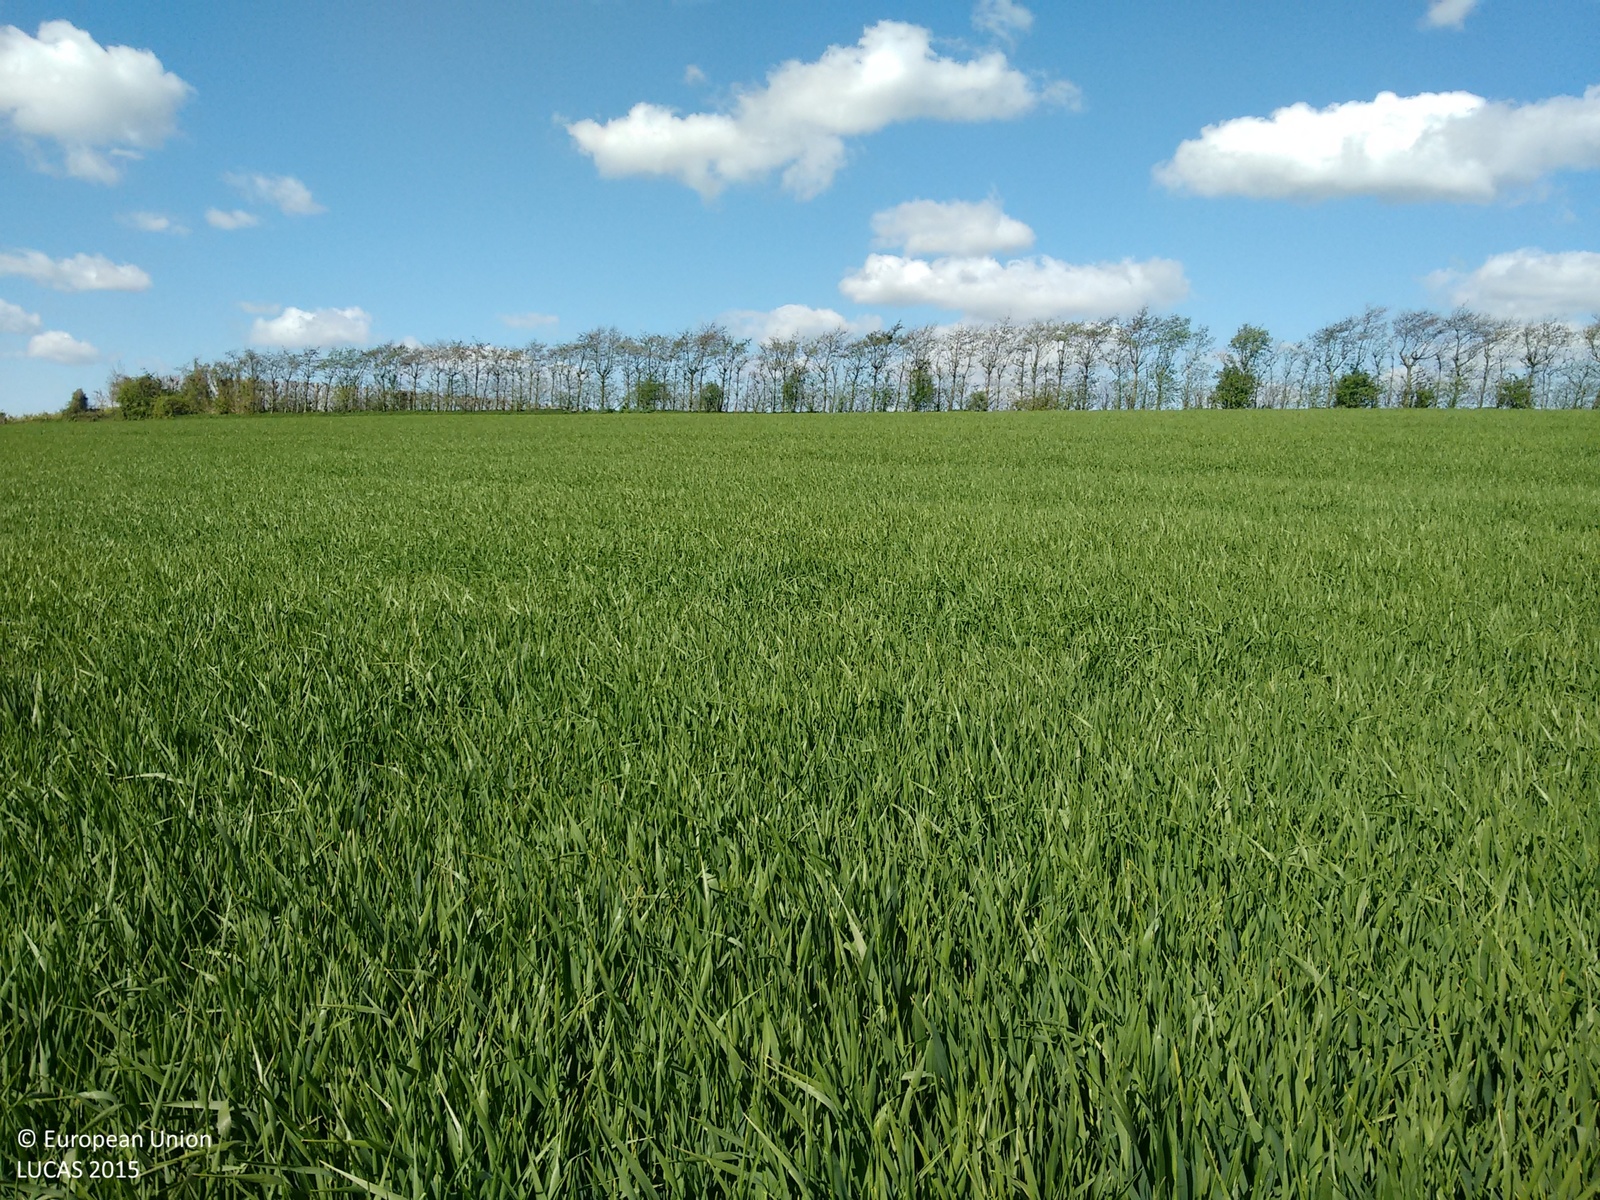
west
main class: Cropland
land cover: Barley
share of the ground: > 75 %
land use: Agriculture (excluding fallow land and kitchen gardens)
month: April
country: GB
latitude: 51.3276
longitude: 0.7465
